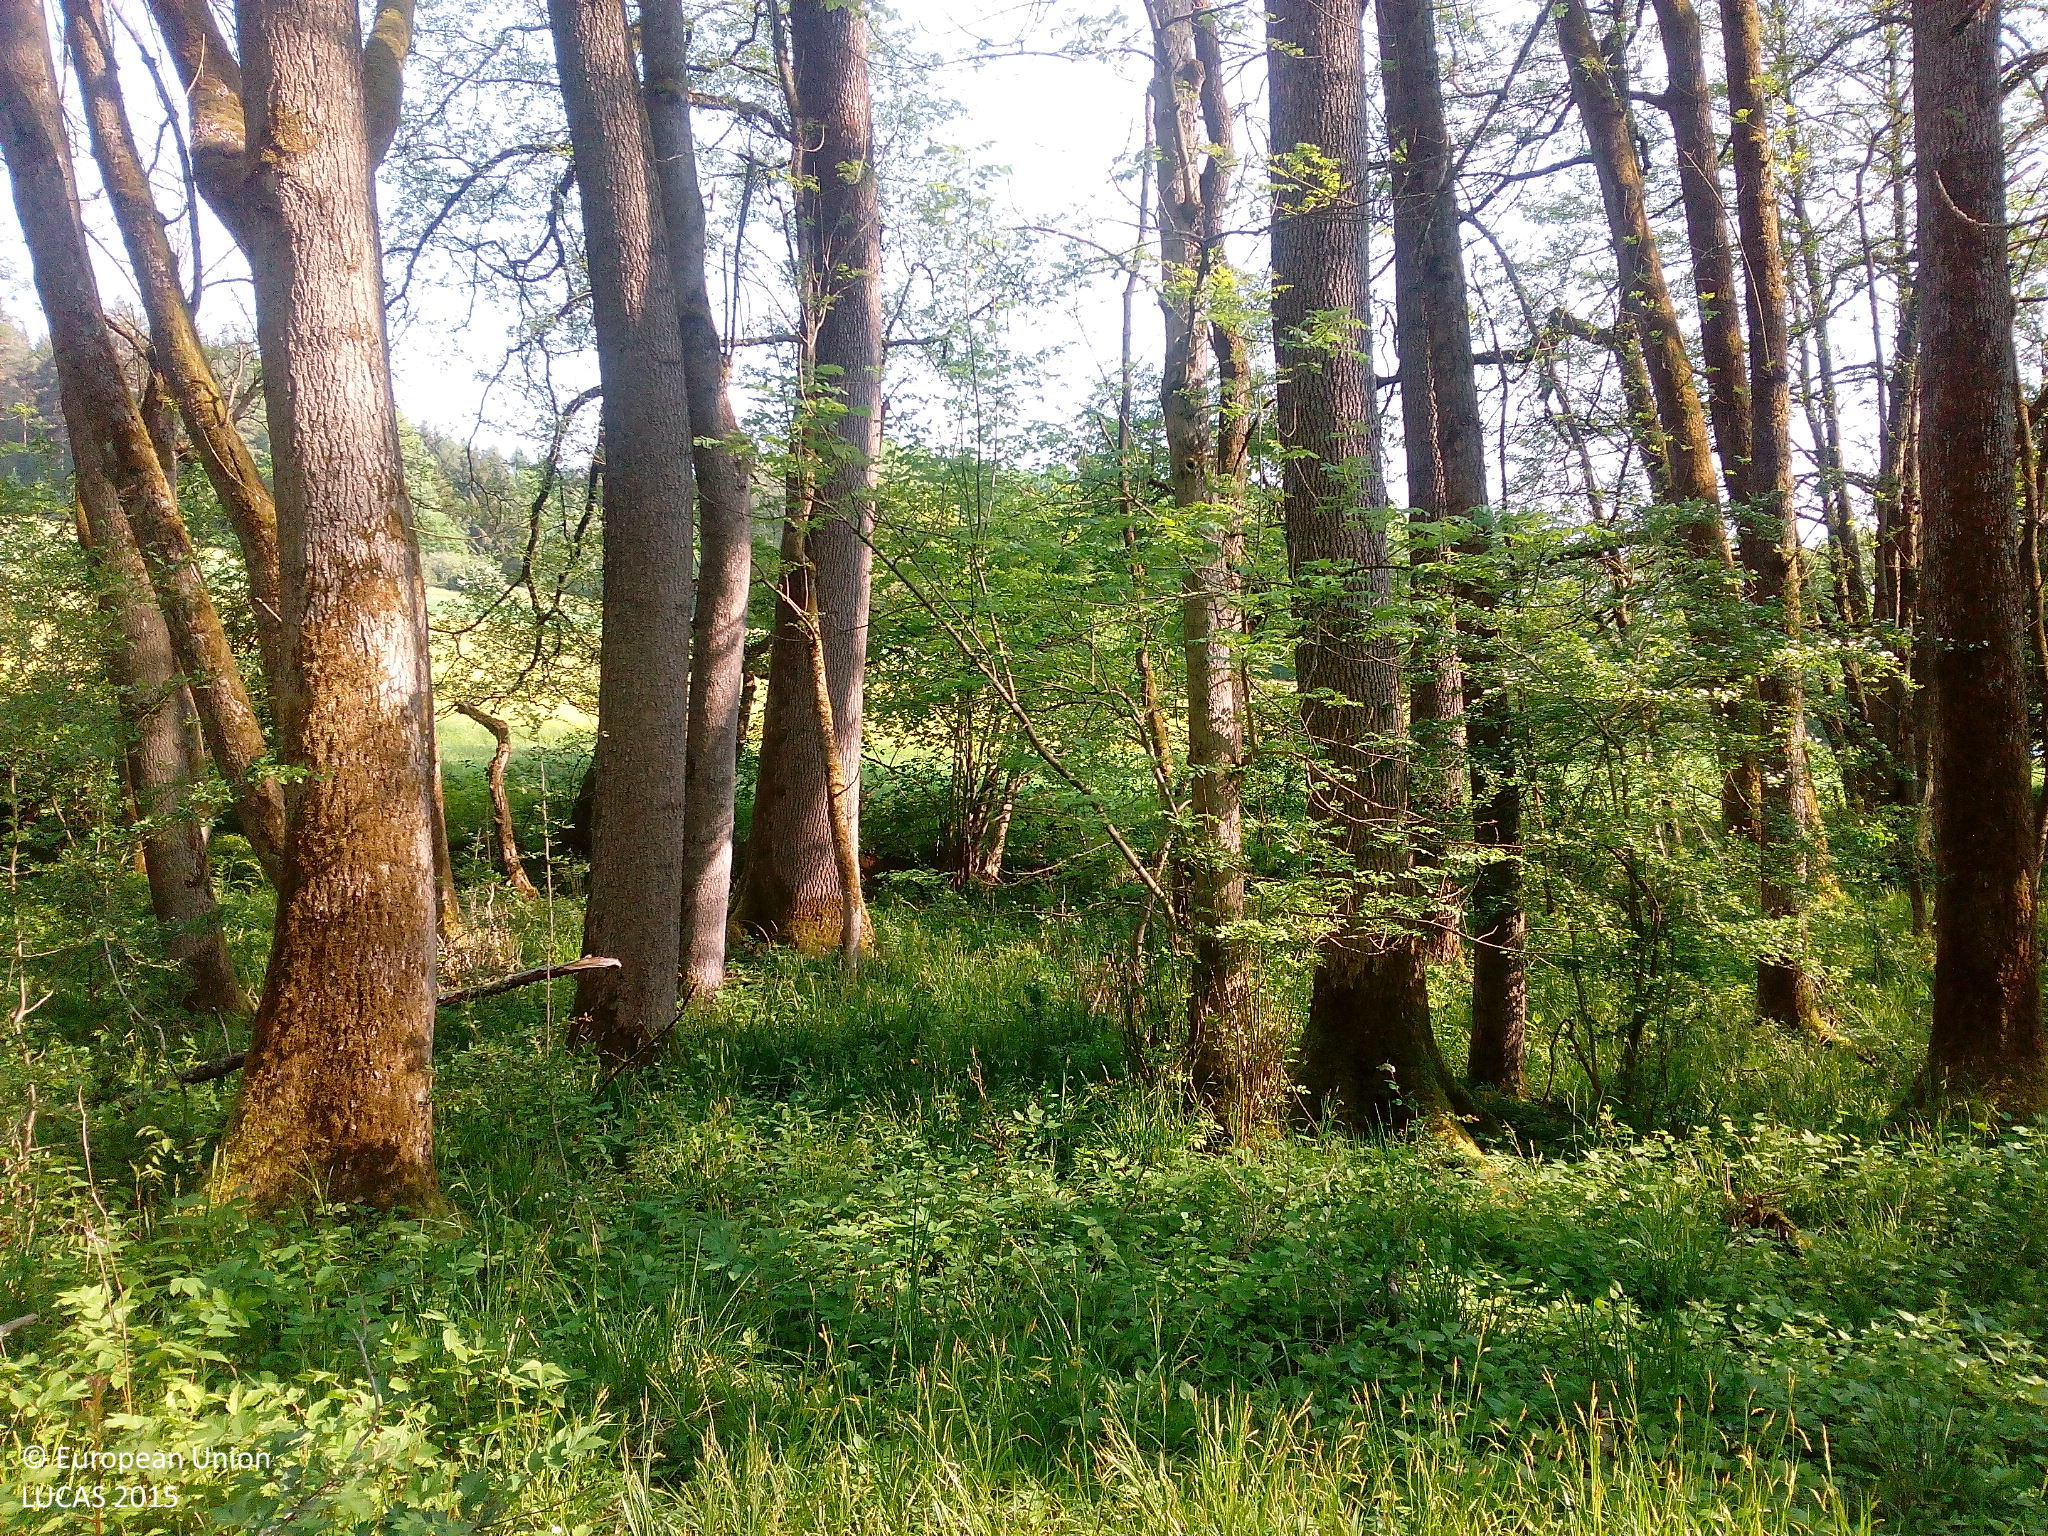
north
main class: Woodland
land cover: Broadleaved woodland
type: mesophytic deciduous forest
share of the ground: > 75 %
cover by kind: broadleaved forest trees 90 %, shrubs 5 %, herbaceous plants 5 %
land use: Forestry
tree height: > 5 m
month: May
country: DE
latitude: 49.8688
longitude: 11.4883
